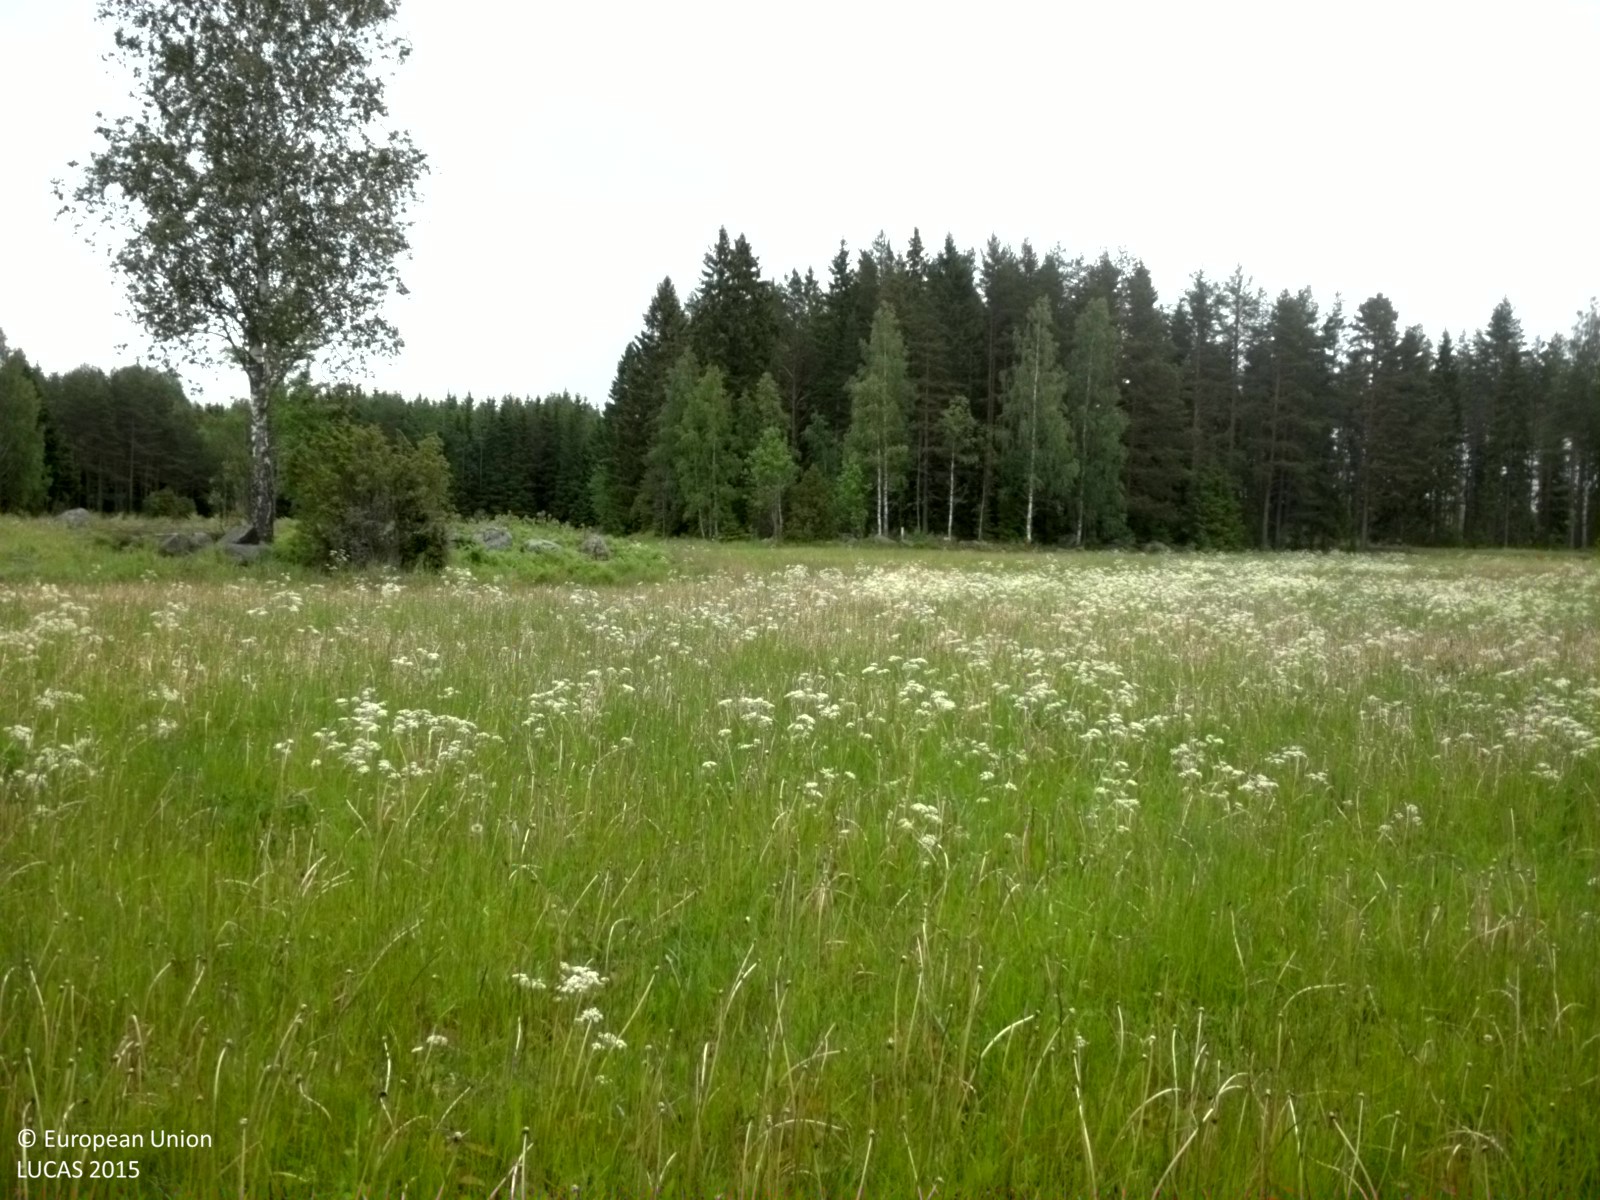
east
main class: Cropland
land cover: Temporary grasslands
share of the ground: > 75 %
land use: Agriculture (excluding fallow land and kitchen gardens)
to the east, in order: Temporary grasslands; Other coniferous woodland; Spruce dominated coniferous woodland; Broadleaved woodland; Grassland with sparse tree/shrub cover; Paved roads, cycling and walking lanes; Grass margins; Broadleaved woodland; Grassland with sparse tree/shrub cover
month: June
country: SE
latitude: 60.2265
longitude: 17.3033
